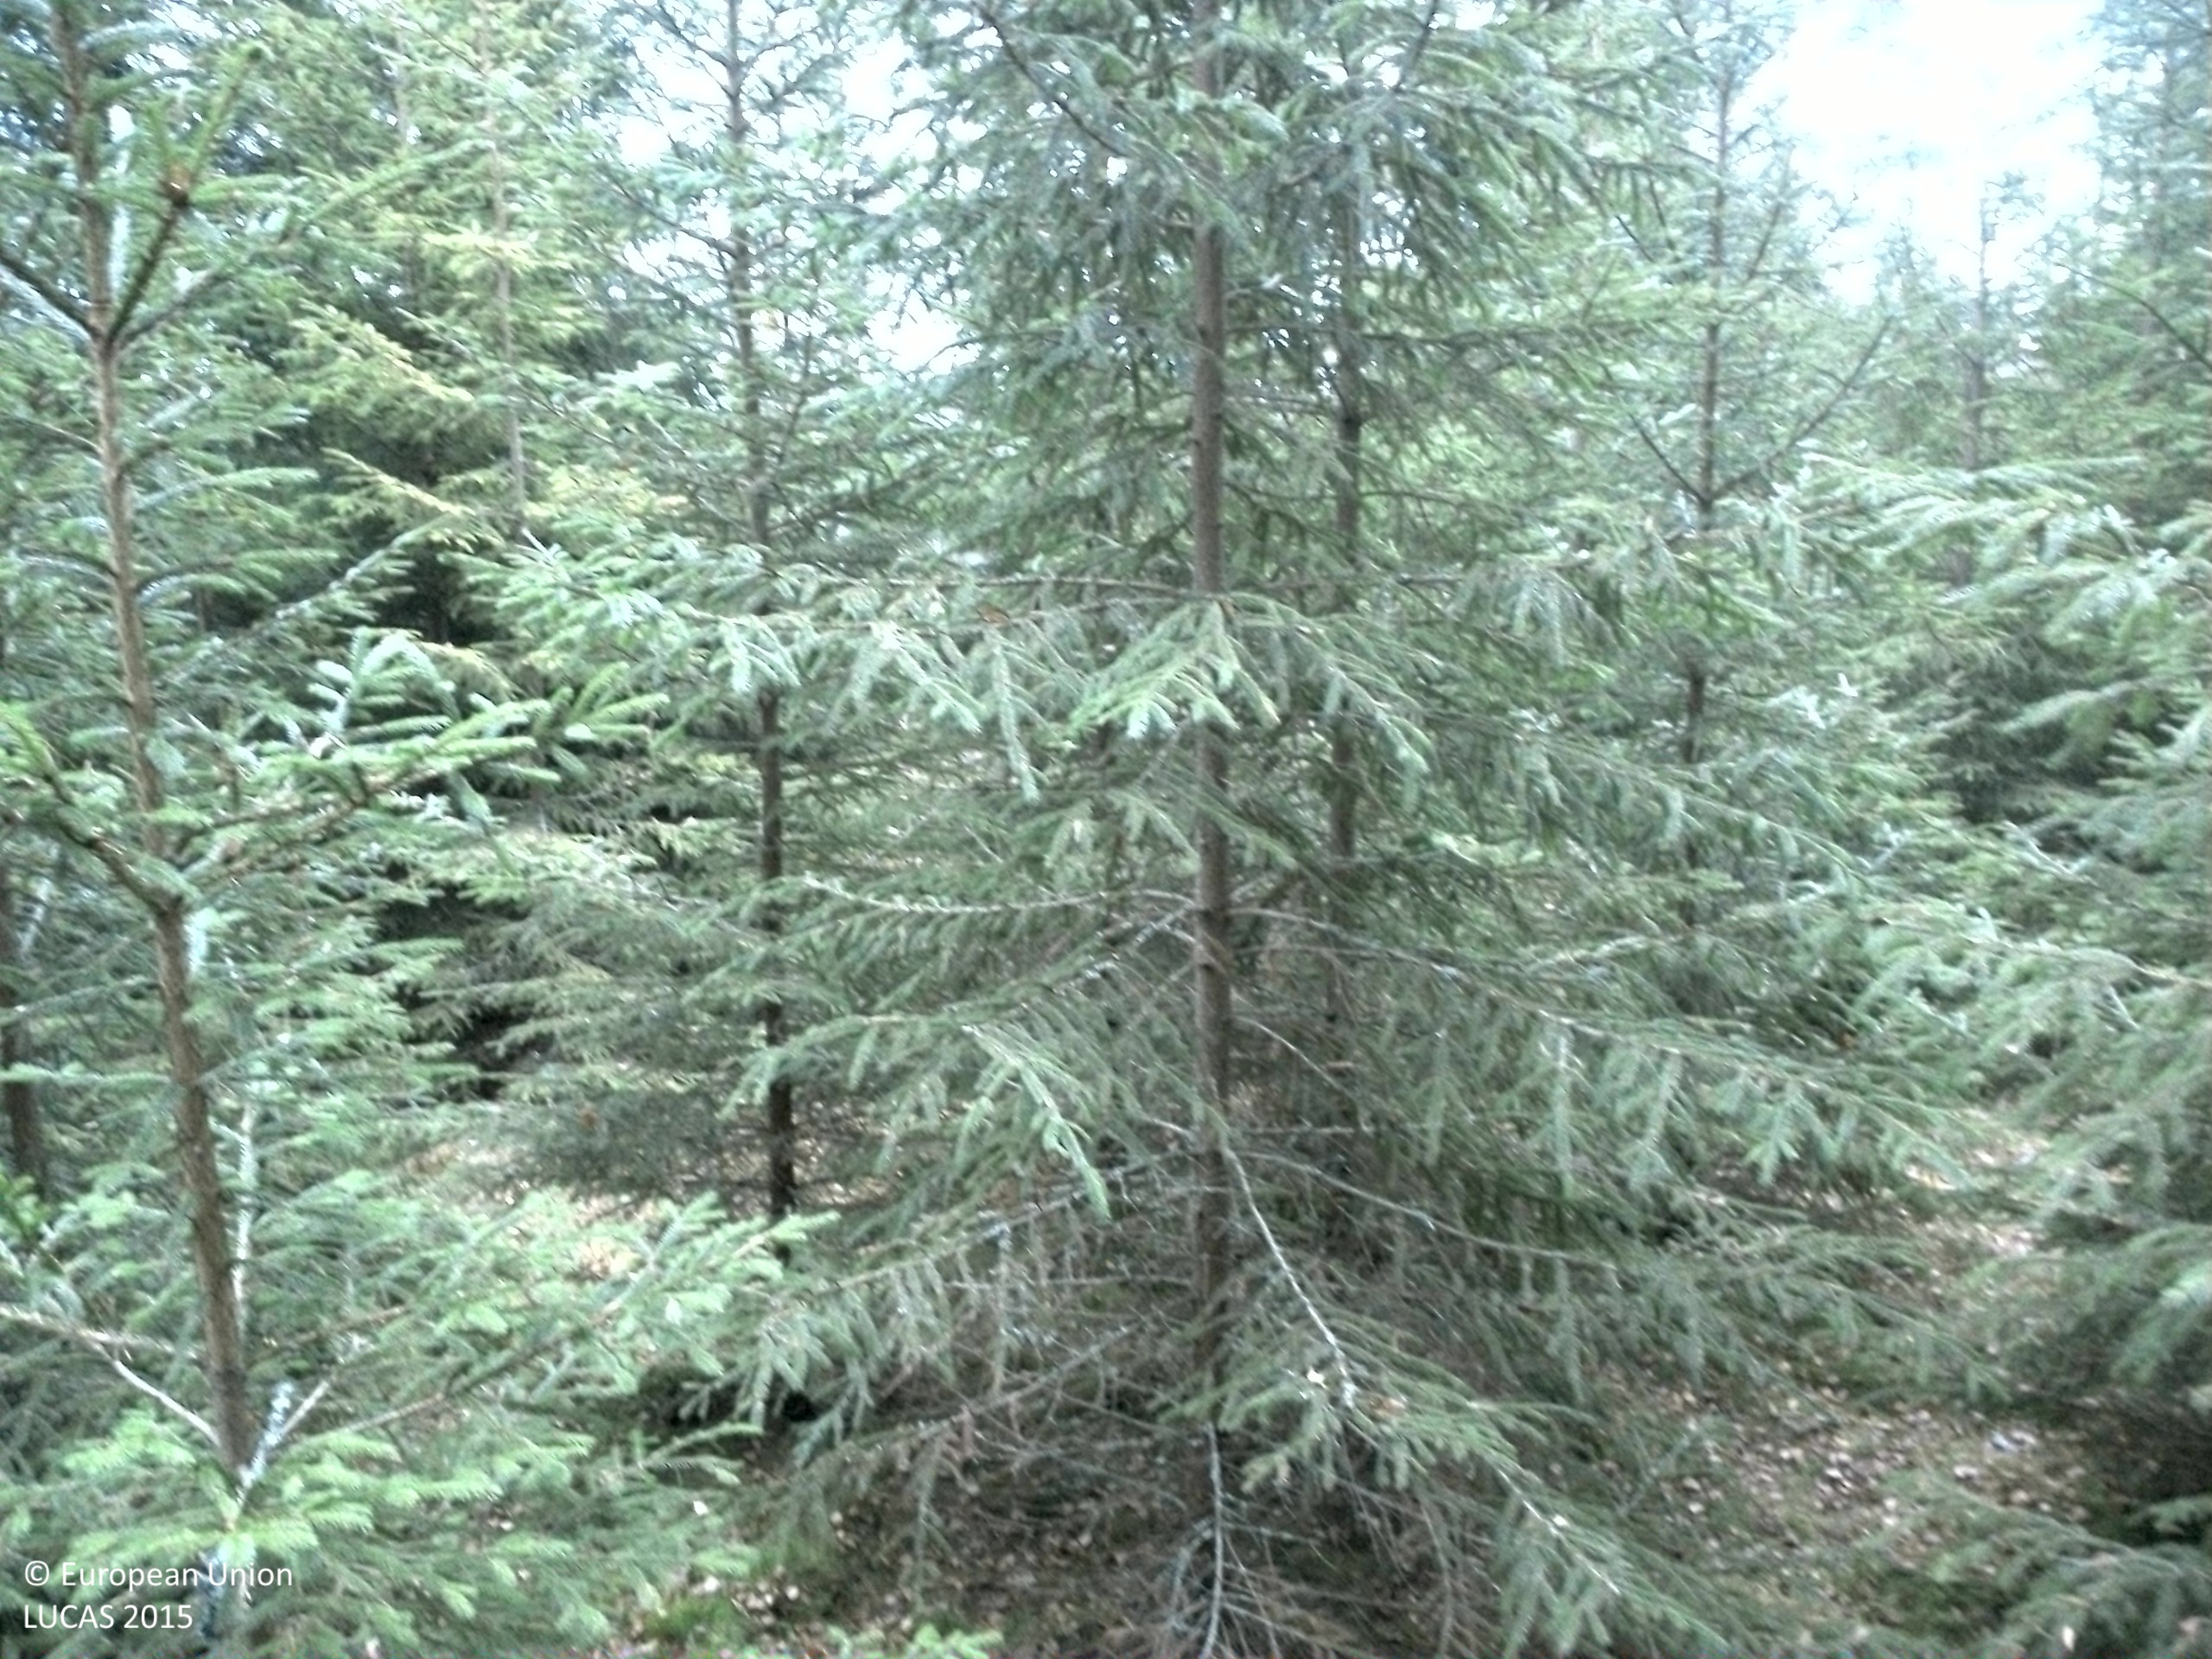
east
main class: Woodland
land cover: Spruce dominated coniferous woodland
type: boreal forest
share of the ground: > 75 %
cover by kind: coniferous forest trees 75 %, herbaceous plants 10 %, lichens and mosses 10 %, shrubs 5 %
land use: Forestry
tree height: > 5 m
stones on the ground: < 10 %
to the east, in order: Spruce dominated coniferous woodland; Spruce dominated mixed woodland; Broadleaved woodland; Fences; Spruce dominated mixed woodland; Ditches and canals; Grassland without tree/shrub cover; Ditches and canals; Grassland without tree/shrub cover; Fences; Grass margins; Ditches and canals; Grassland with sparse tree/shrub cover; Ditches and canals; Spruce dominated mixed woodland; Grassland with sparse tree/shrub cover
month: November
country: SE
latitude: 57.8648
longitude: 14.7652
